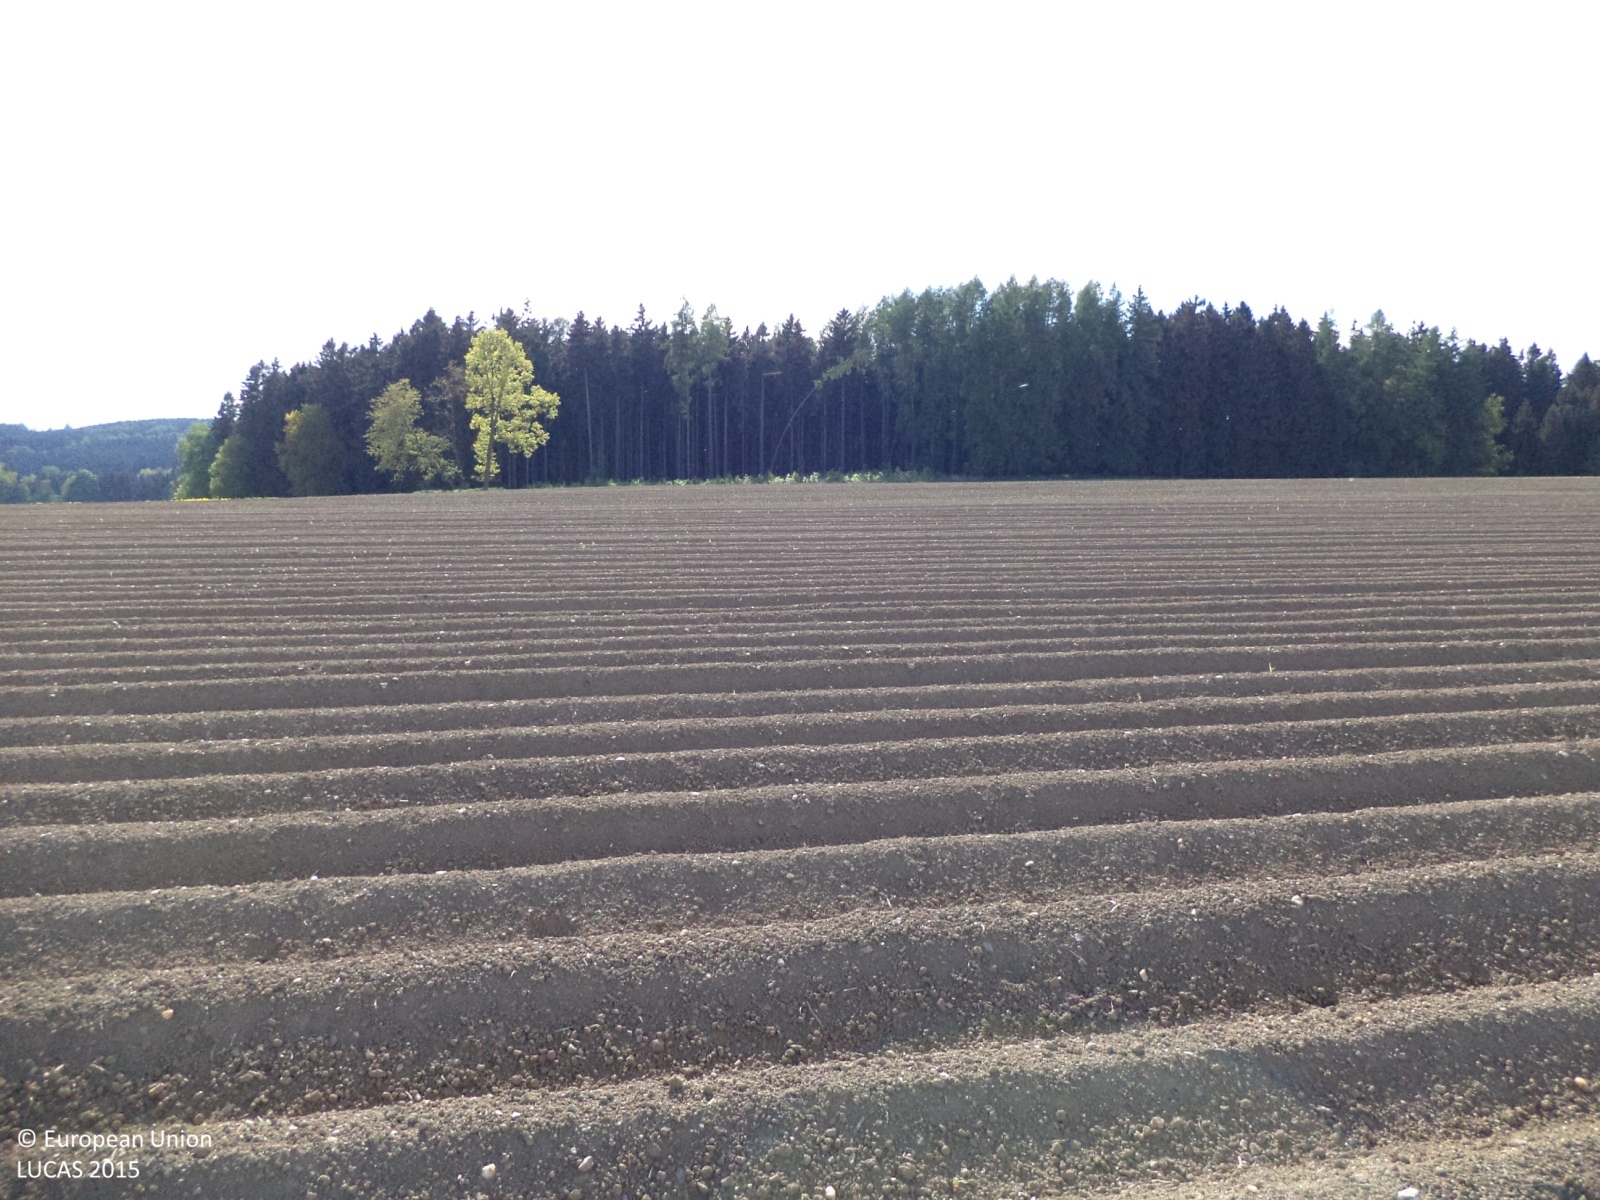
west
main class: Cropland
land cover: Potatoes
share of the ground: < 10 %
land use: Agriculture (excluding fallow land and kitchen gardens)
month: May
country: CZ
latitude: 49.4578
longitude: 15.0934
